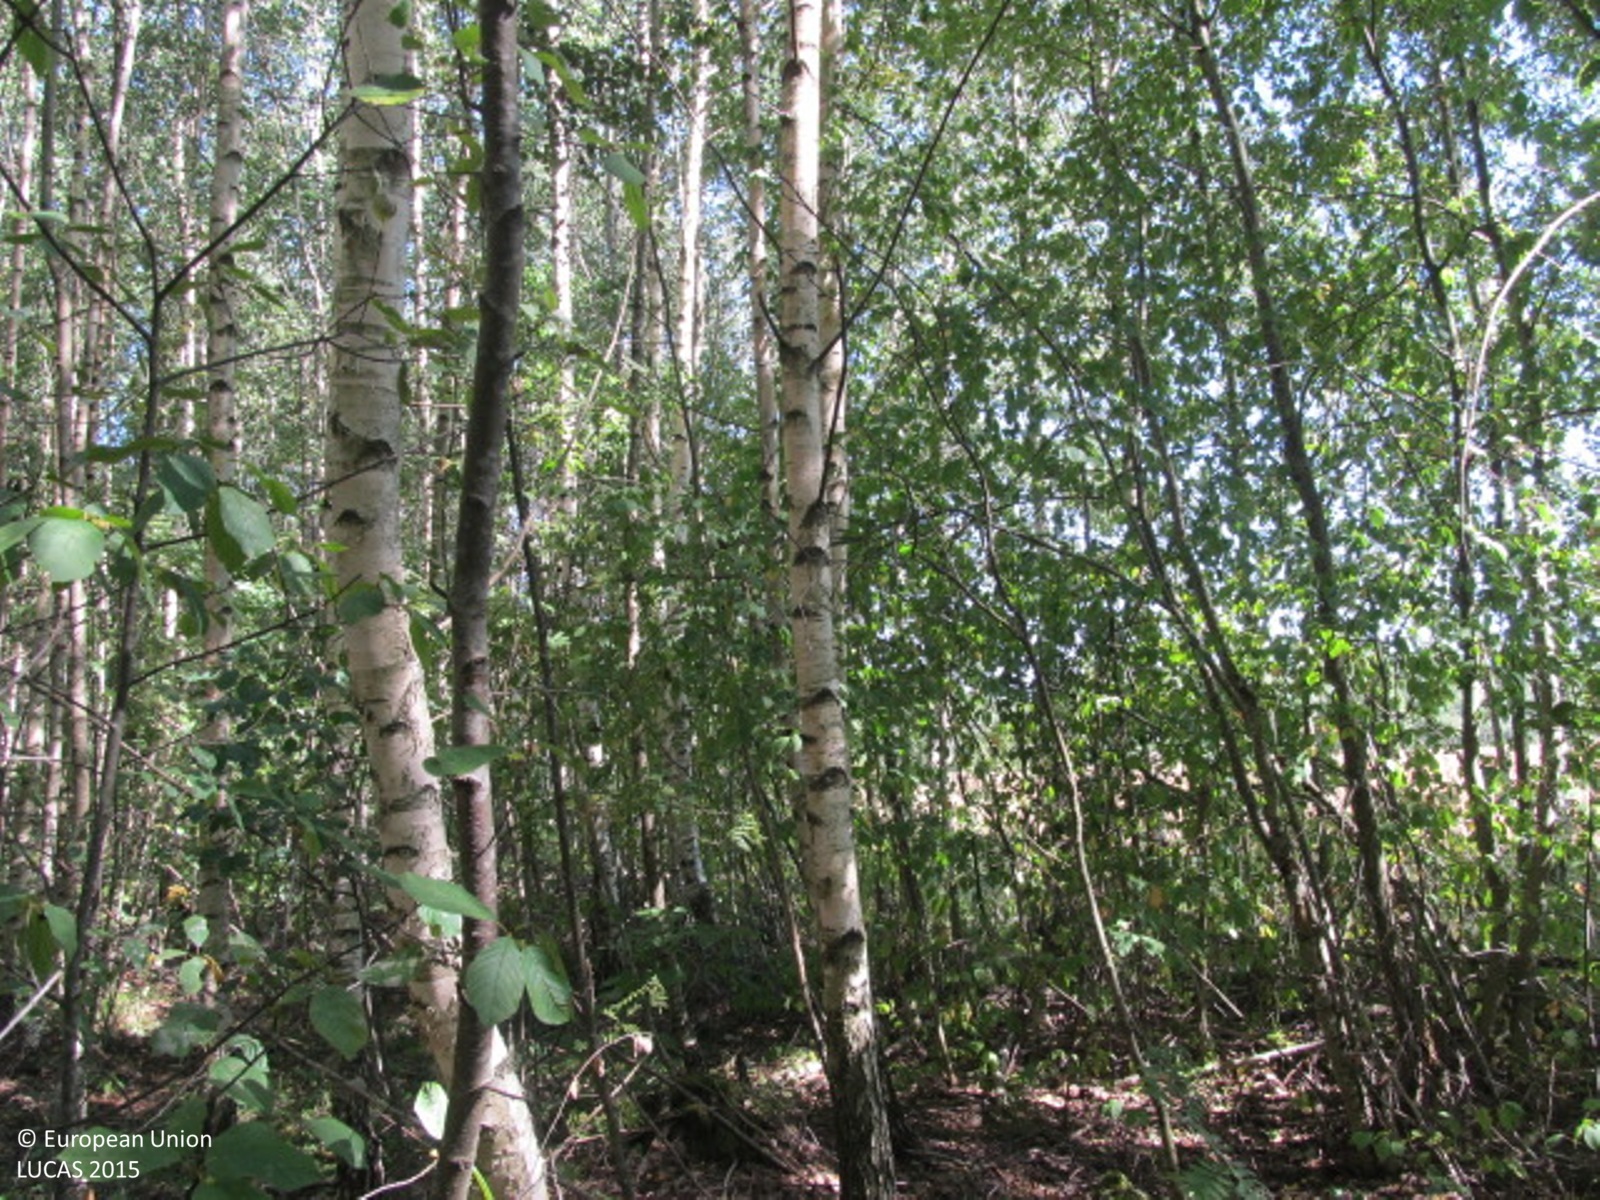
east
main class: Woodland
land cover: Broadleaved woodland
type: non-riverine alder, birch or aspen forest
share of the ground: > 75 %
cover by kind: broadleaved forest trees 85 %, herbaceous plants 10 %, shrubs 5 %
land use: Forestry
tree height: > 5 m
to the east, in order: Broadleaved woodland; Barley; Shruby margins; Barley; Spontaneously vegetated surfaces; Tracks; Grassland with sparse tree/shrub cover; Spruce dominated mixed woodland; Inland fresh running water
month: August
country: LT
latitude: 56.1385
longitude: 22.4981
